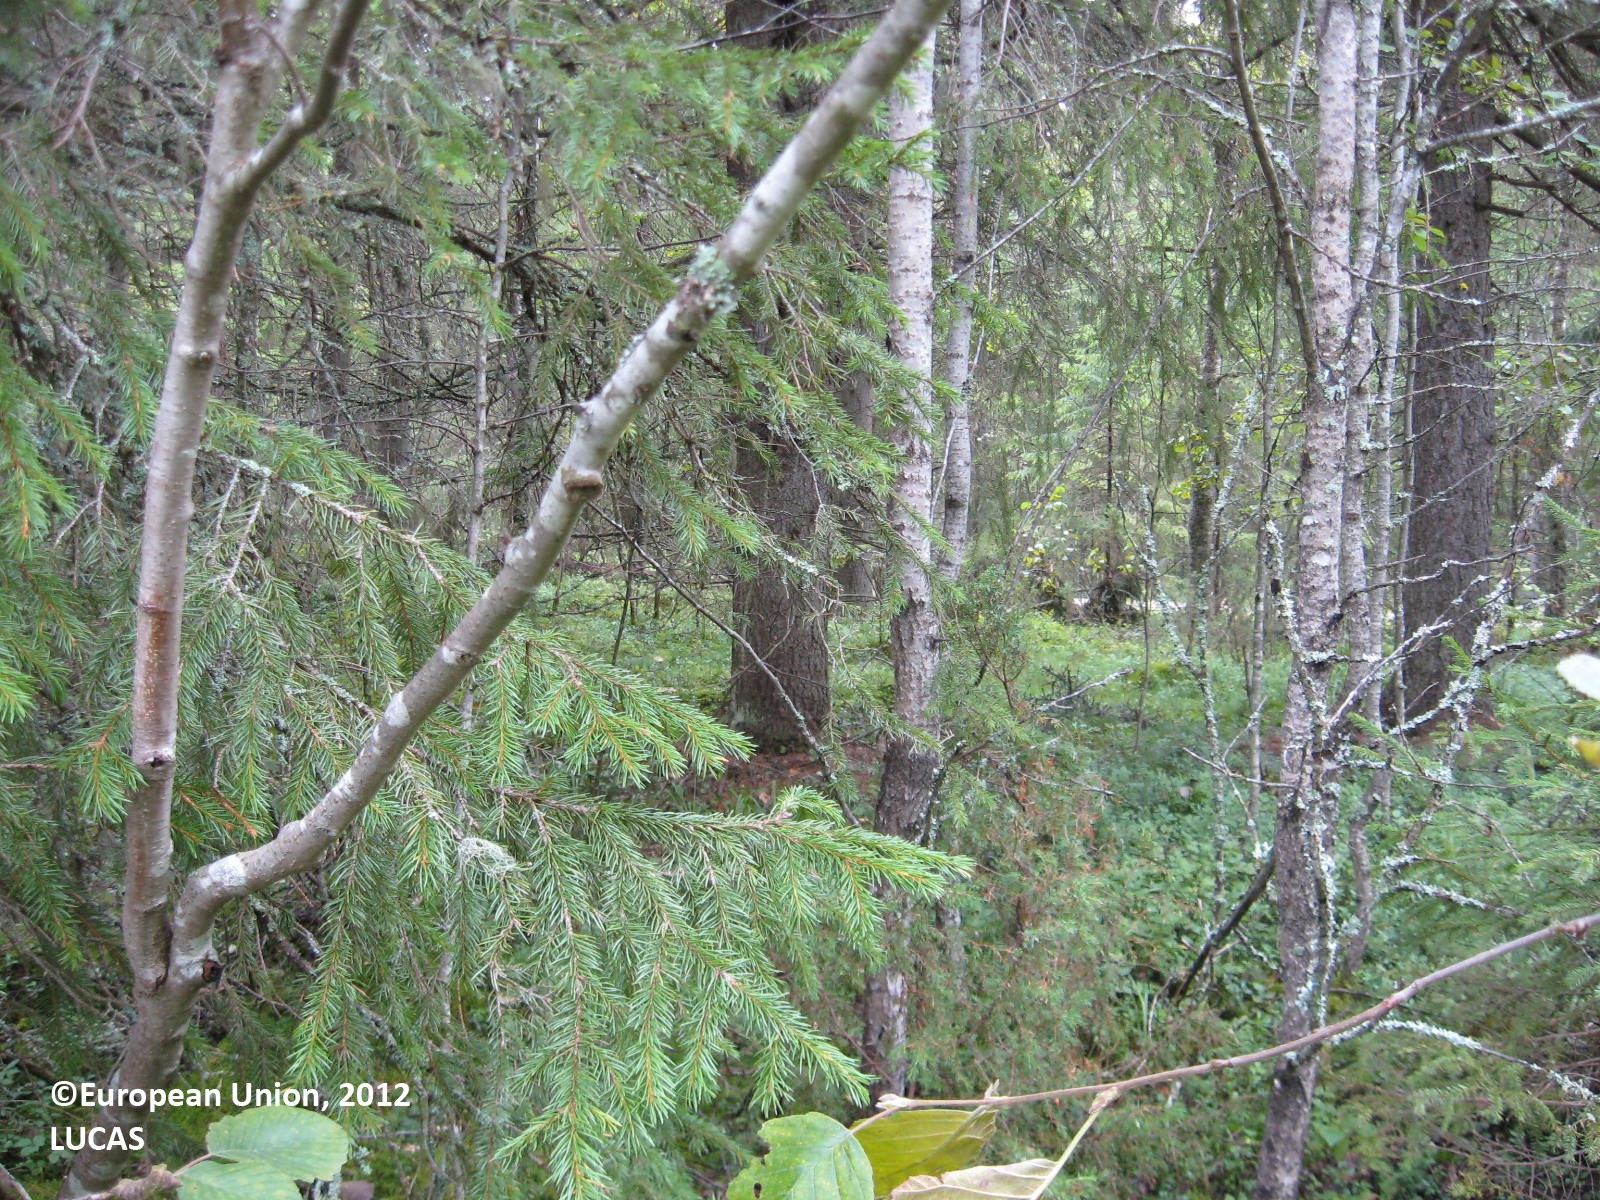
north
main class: Woodland
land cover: Spruce dominated coniferous woodland
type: boreal forest
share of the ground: > 75 %
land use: Forestry
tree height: > 5 m
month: August
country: FI
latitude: 63.6209
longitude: 29.0287
